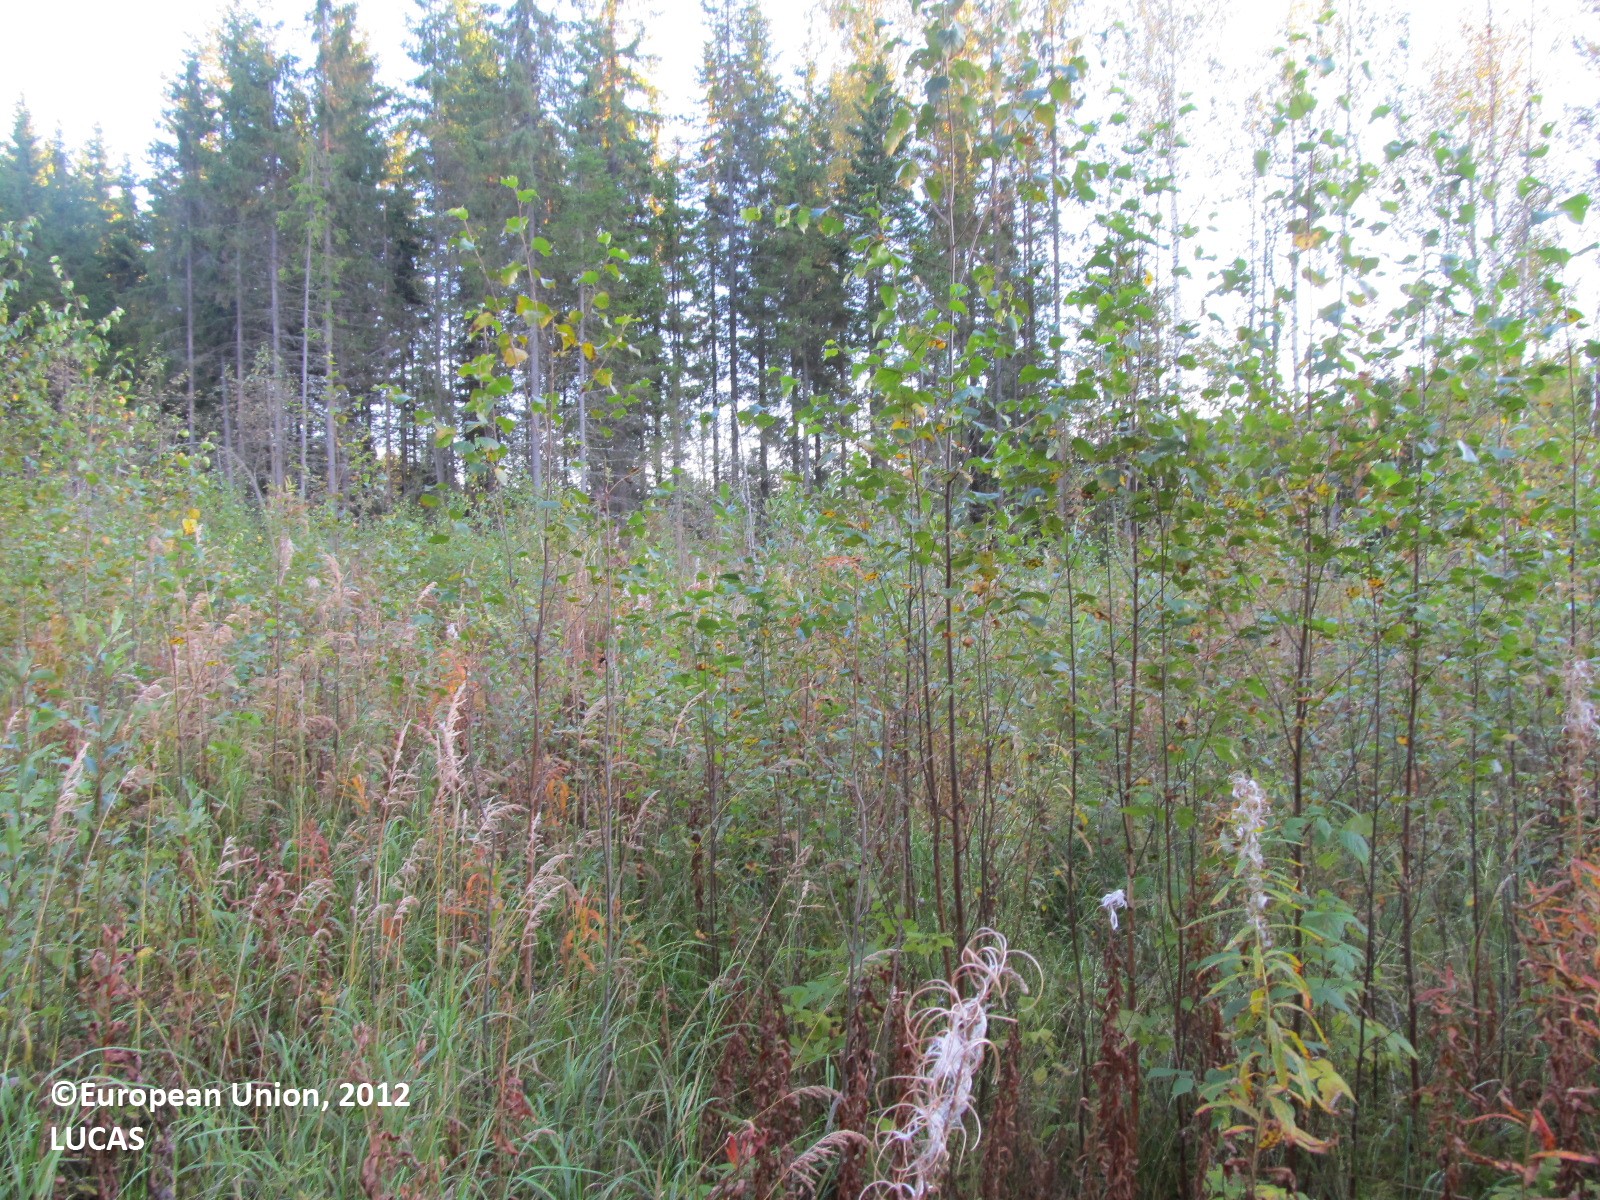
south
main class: Woodland
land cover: Broadleaved woodland
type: boreal forest
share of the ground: 25 - 50 %
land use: Forestry
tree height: > 5 m
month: September
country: FI
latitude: 62.3991
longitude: 28.6455
